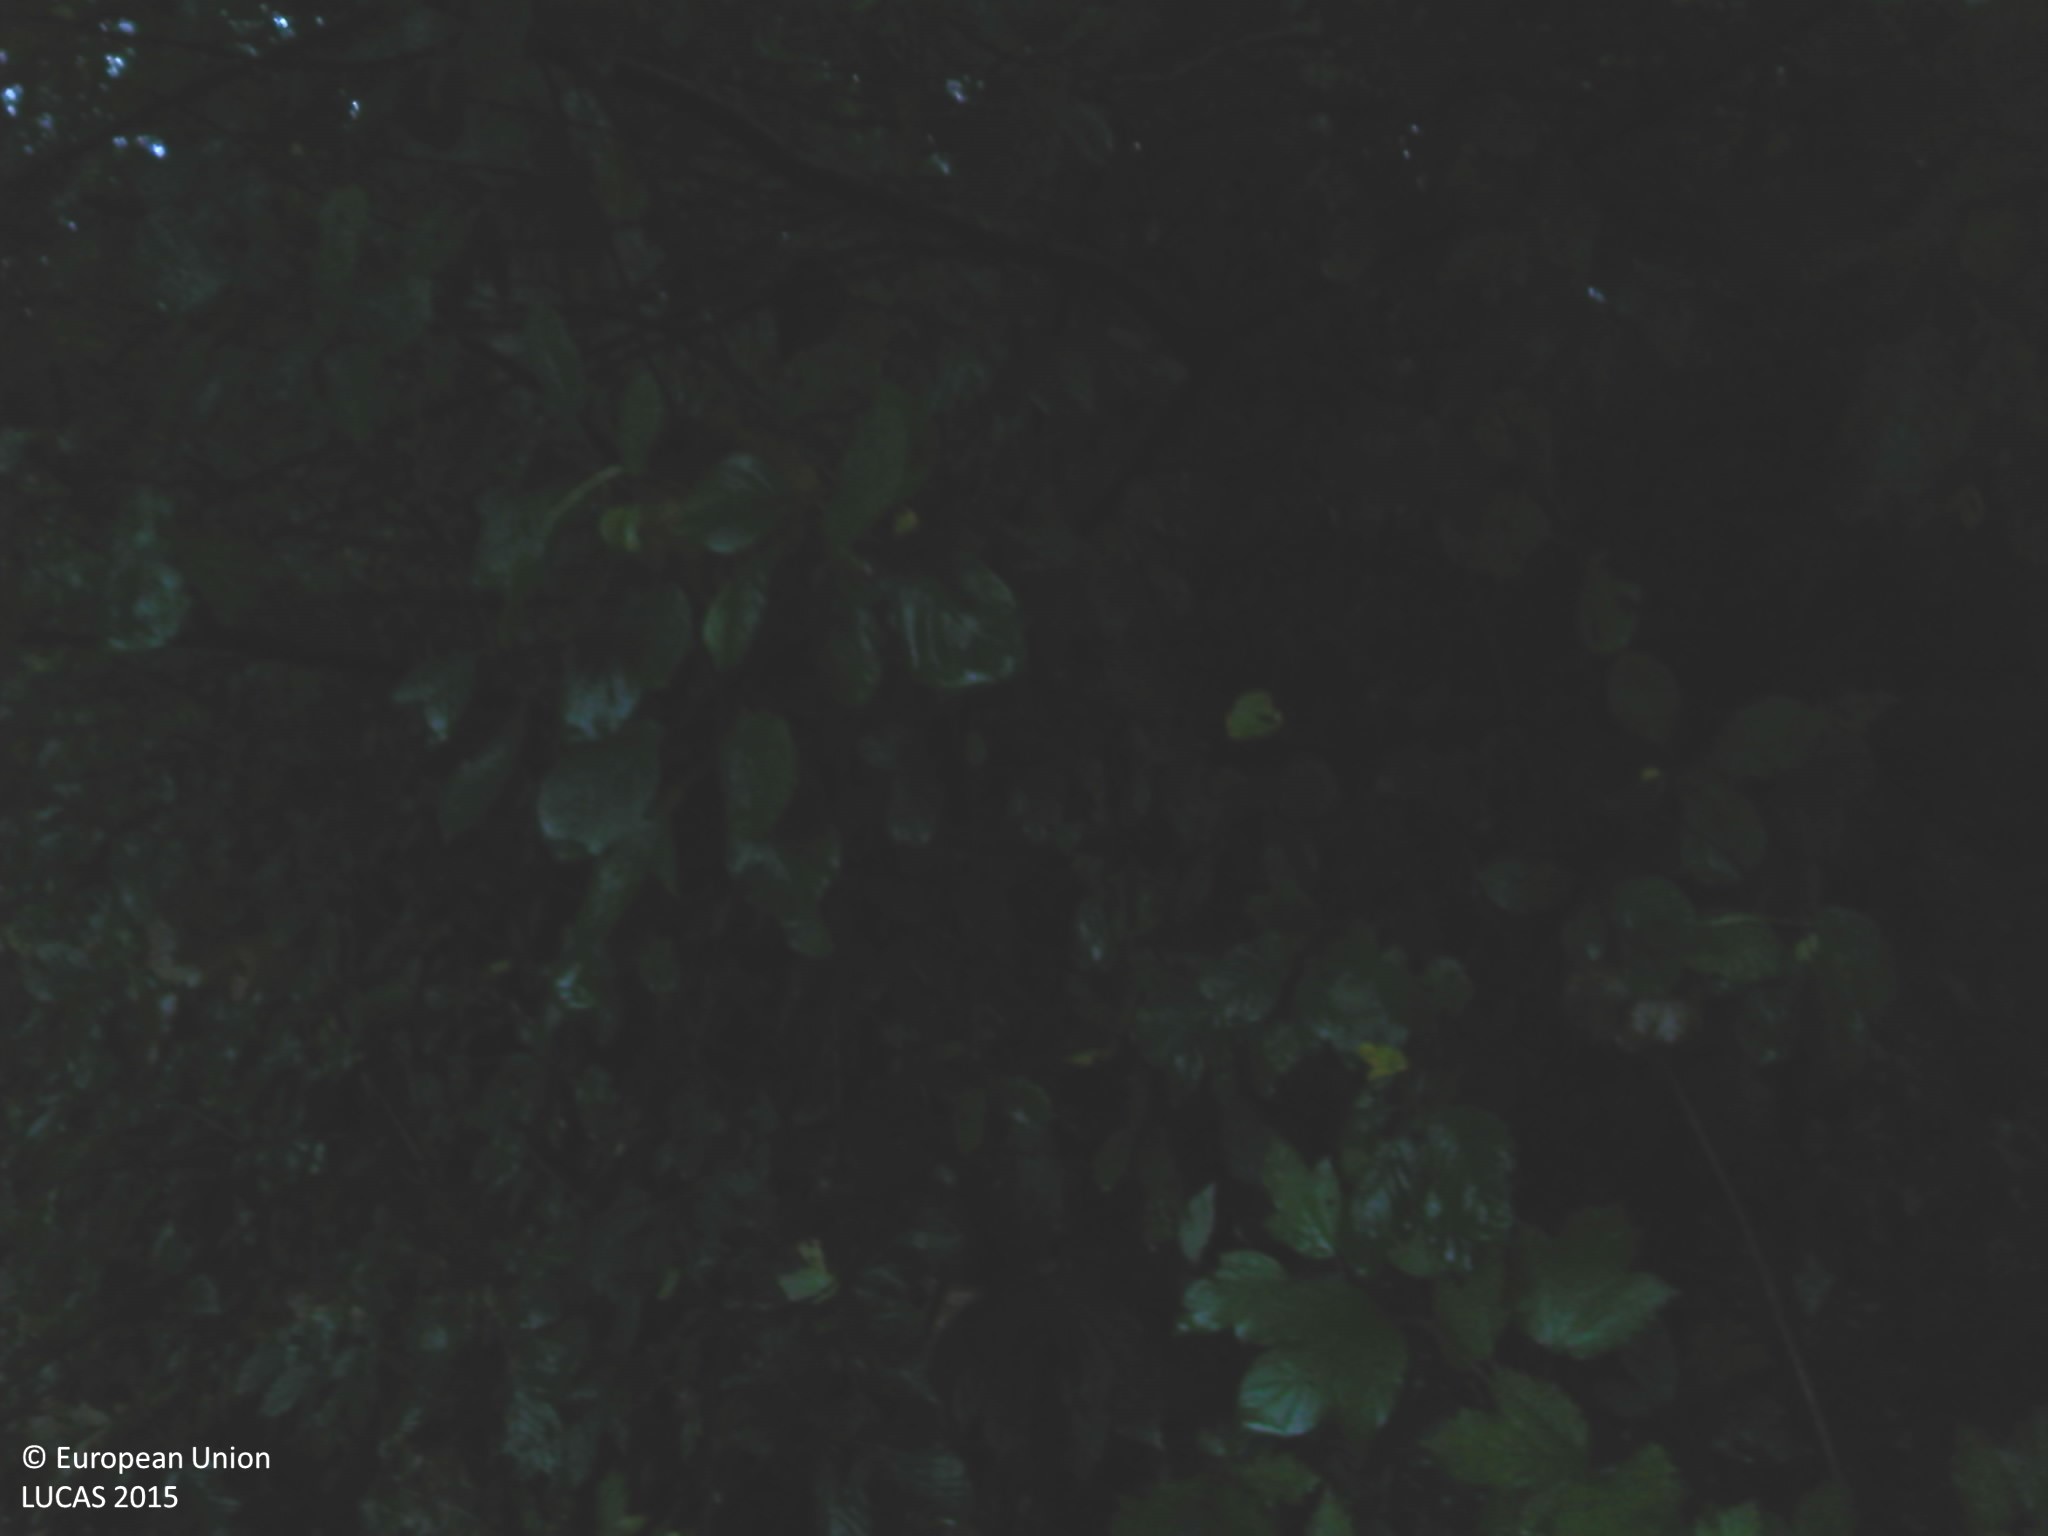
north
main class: Grassland
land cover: Grassland without tree/shrub cover
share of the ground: > 75 %
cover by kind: herbaceous plants 100 %
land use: Residential
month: October
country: BE
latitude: 51.3269
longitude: 4.4129
